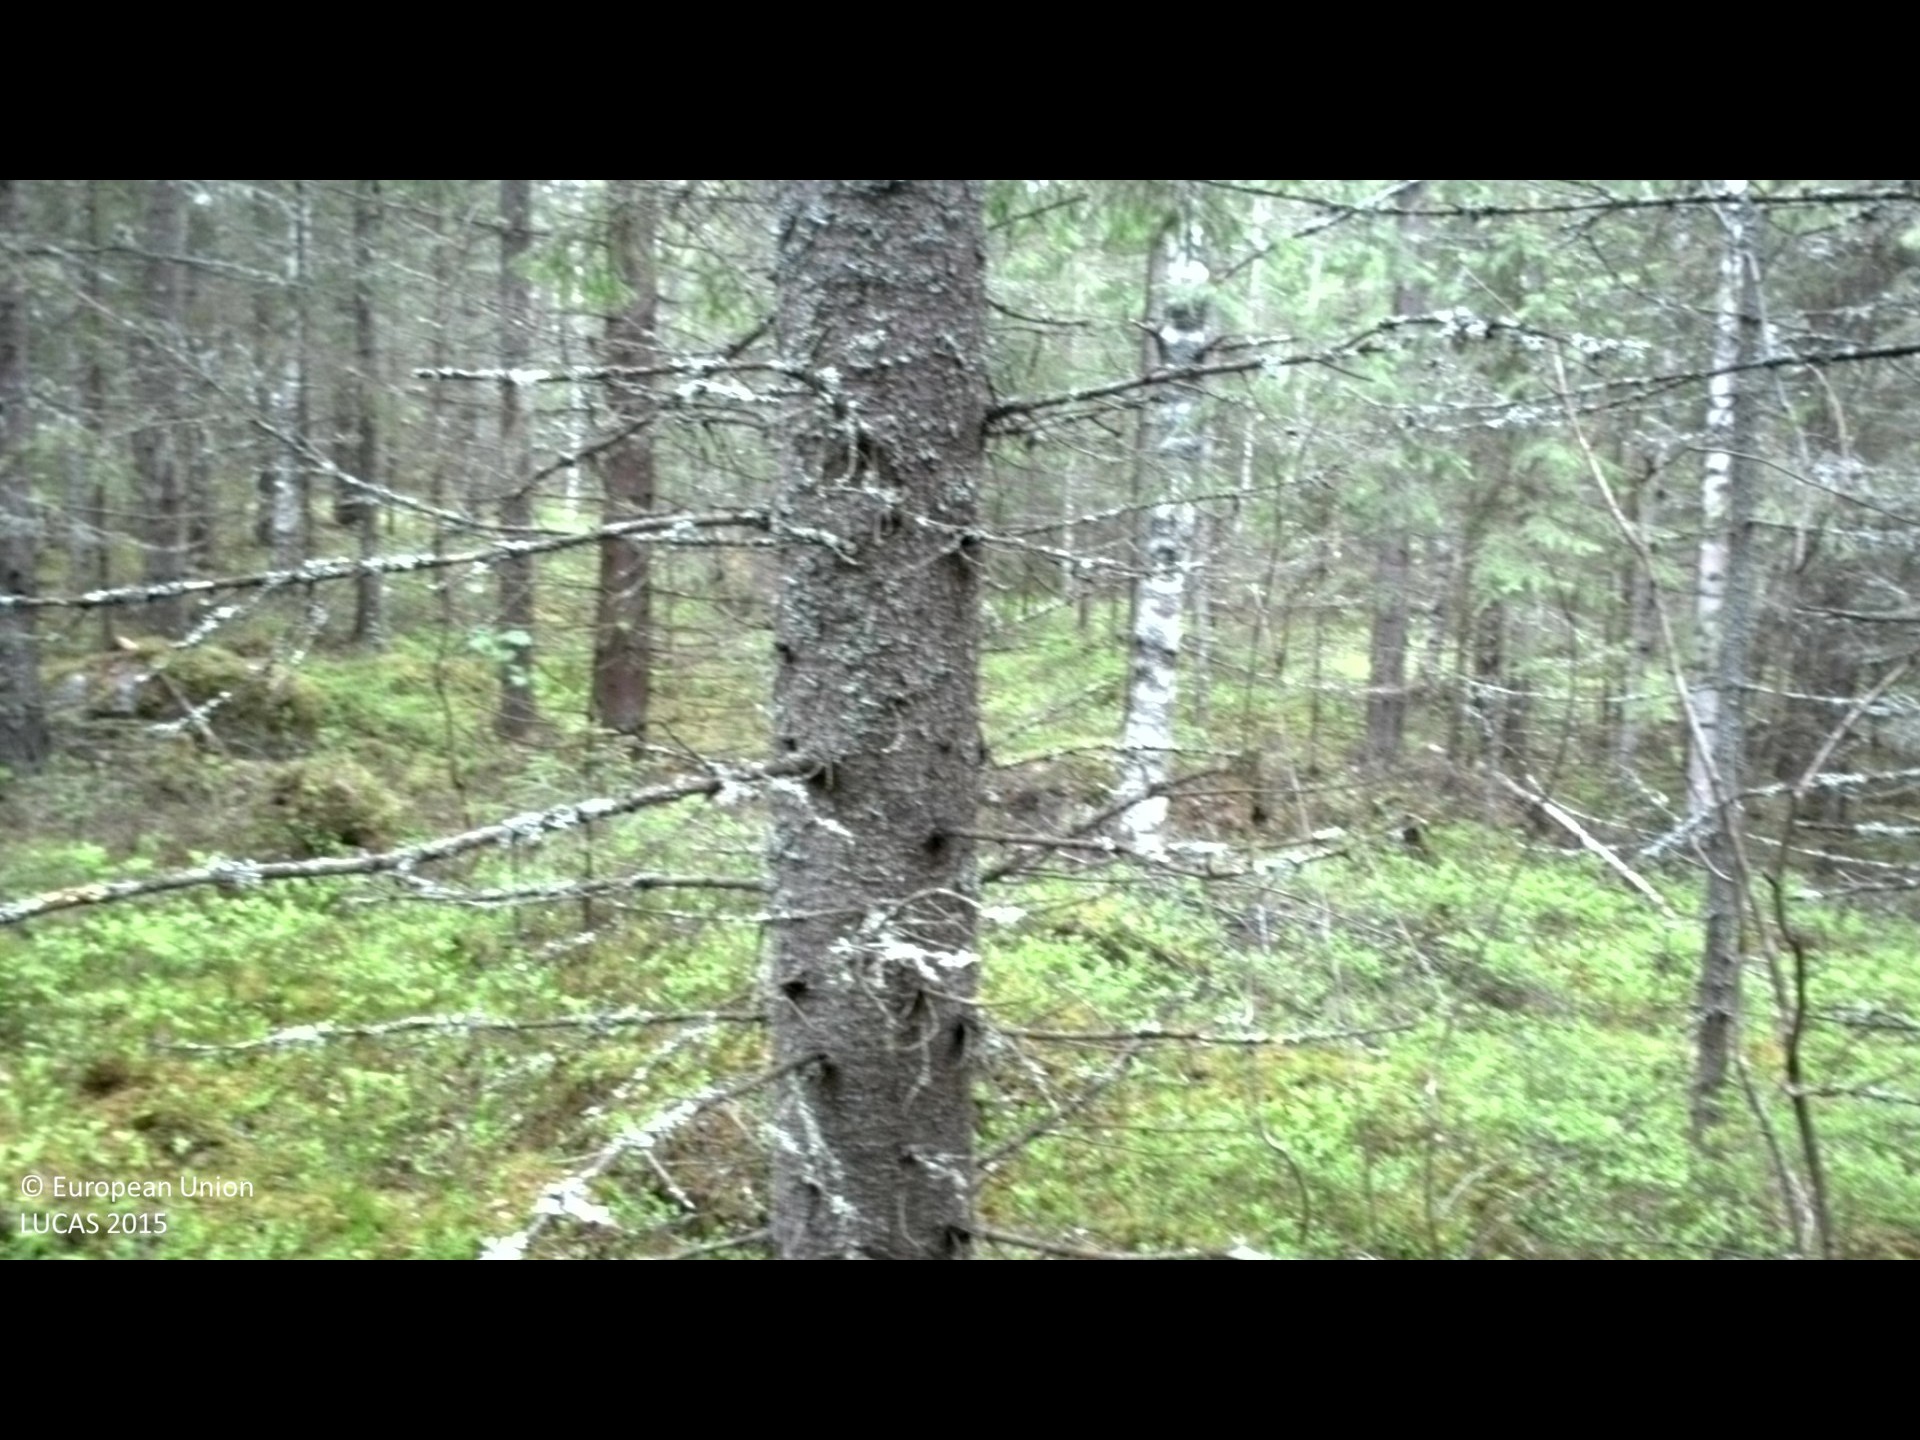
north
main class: Woodland
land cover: Spruce dominated mixed woodland
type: boreal forest
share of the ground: > 75 %
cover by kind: coniferous forest trees 60 %, broadleaved forest trees 20 %, shrubs 20 %
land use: Forestry
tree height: > 5 m
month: May
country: SE
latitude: 62.9777
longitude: 17.6915
